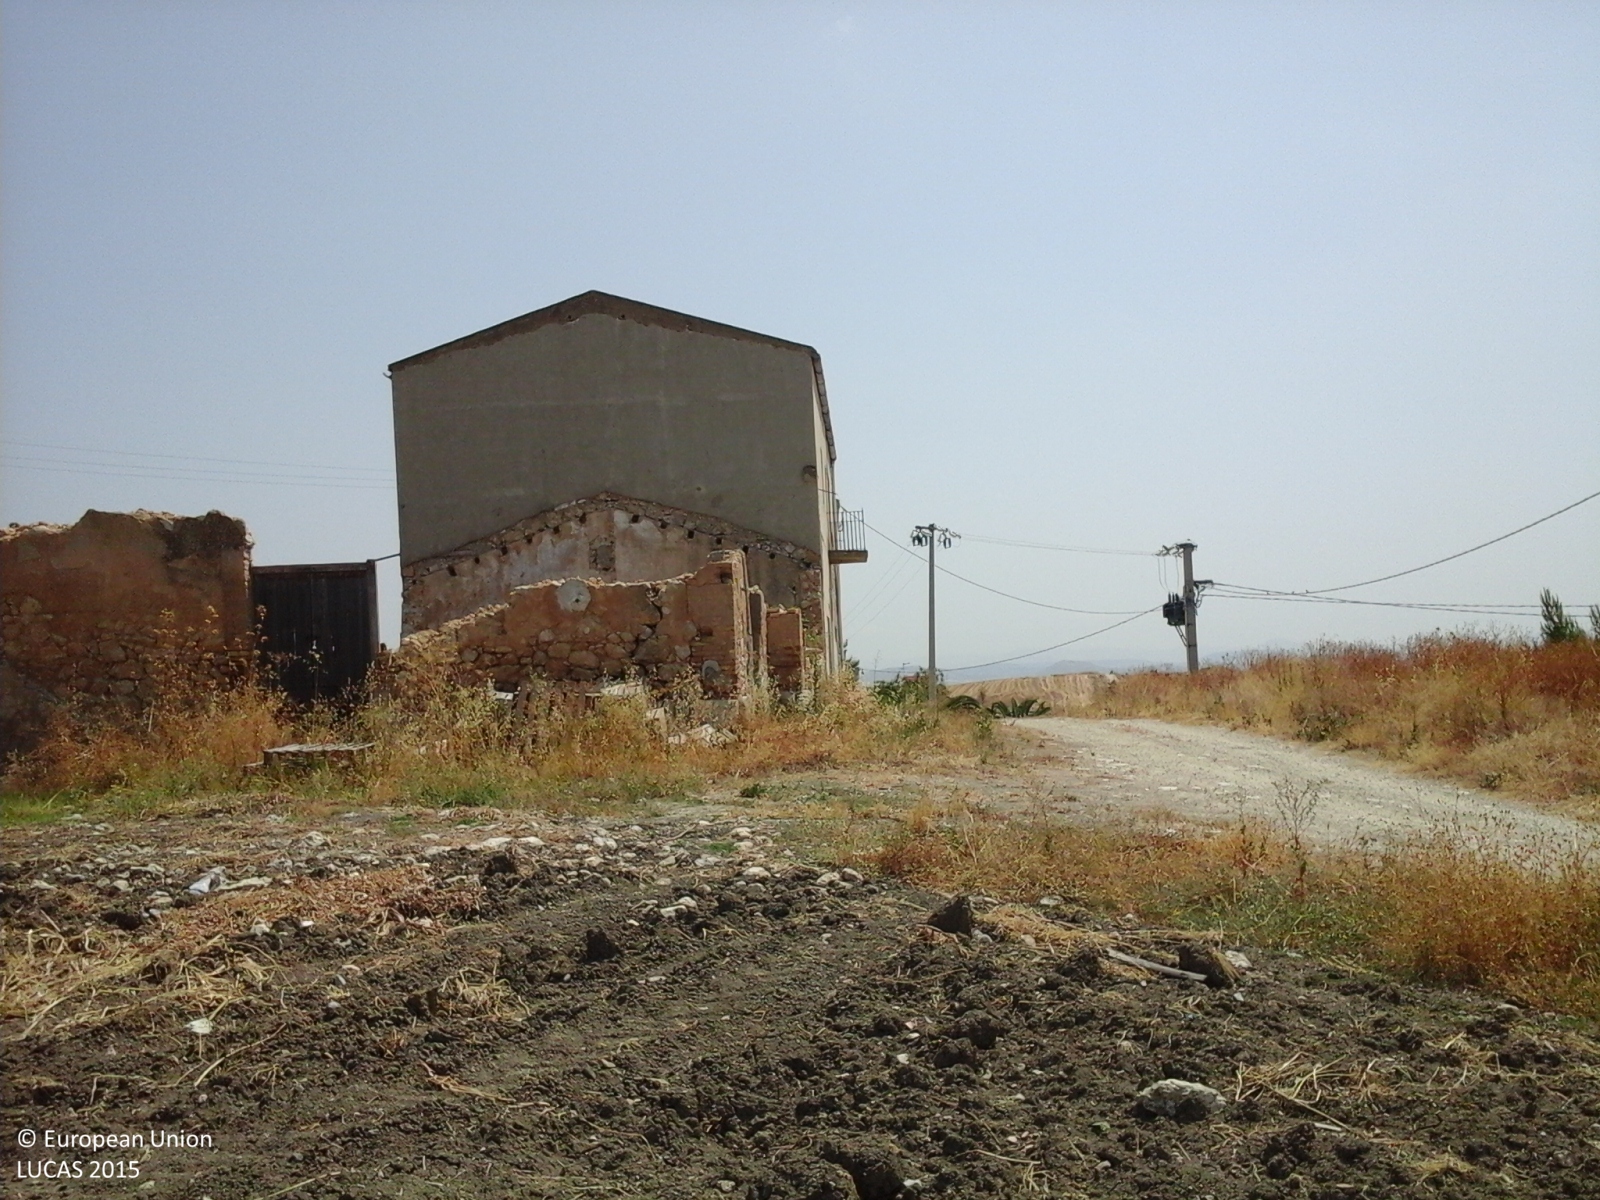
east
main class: Cropland
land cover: Arable land (only in case pi)
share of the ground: > 75 %
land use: Agriculture (excluding fallow land and kitchen gardens)
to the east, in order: Arable land (only in case pi); Permanent crops (only in case pi); Fences; Tracks; Electric lines; Nuts trees; Rocks and stones; Dry pulses; Electric lines; Dry pulses
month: July
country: IT
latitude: 37.3544
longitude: 13.9998
